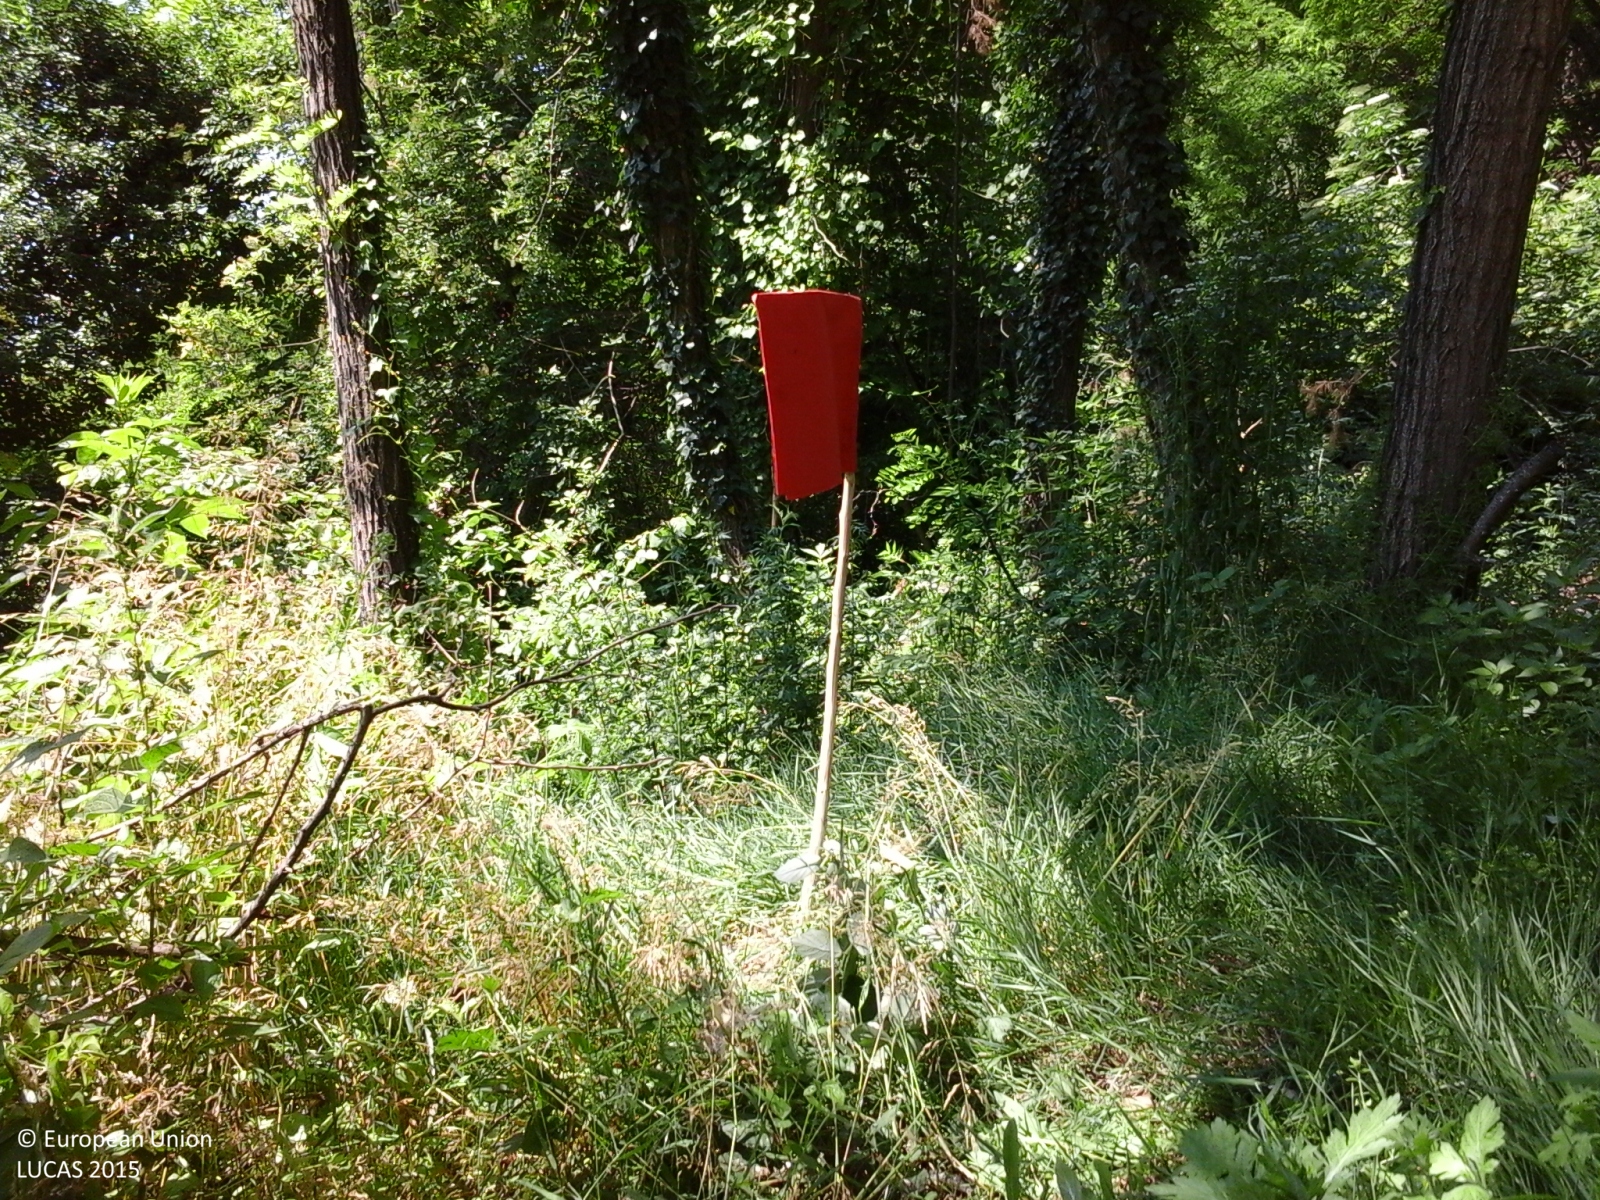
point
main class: Woodland
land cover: Broadleaved woodland
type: mesophytic deciduous forest
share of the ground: > 75 %
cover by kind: broadleaved forest trees 90 %, shrubs 10 %
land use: Forestry
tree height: > 5 m
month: June
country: IT
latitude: 44.6060
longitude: 8.2271
